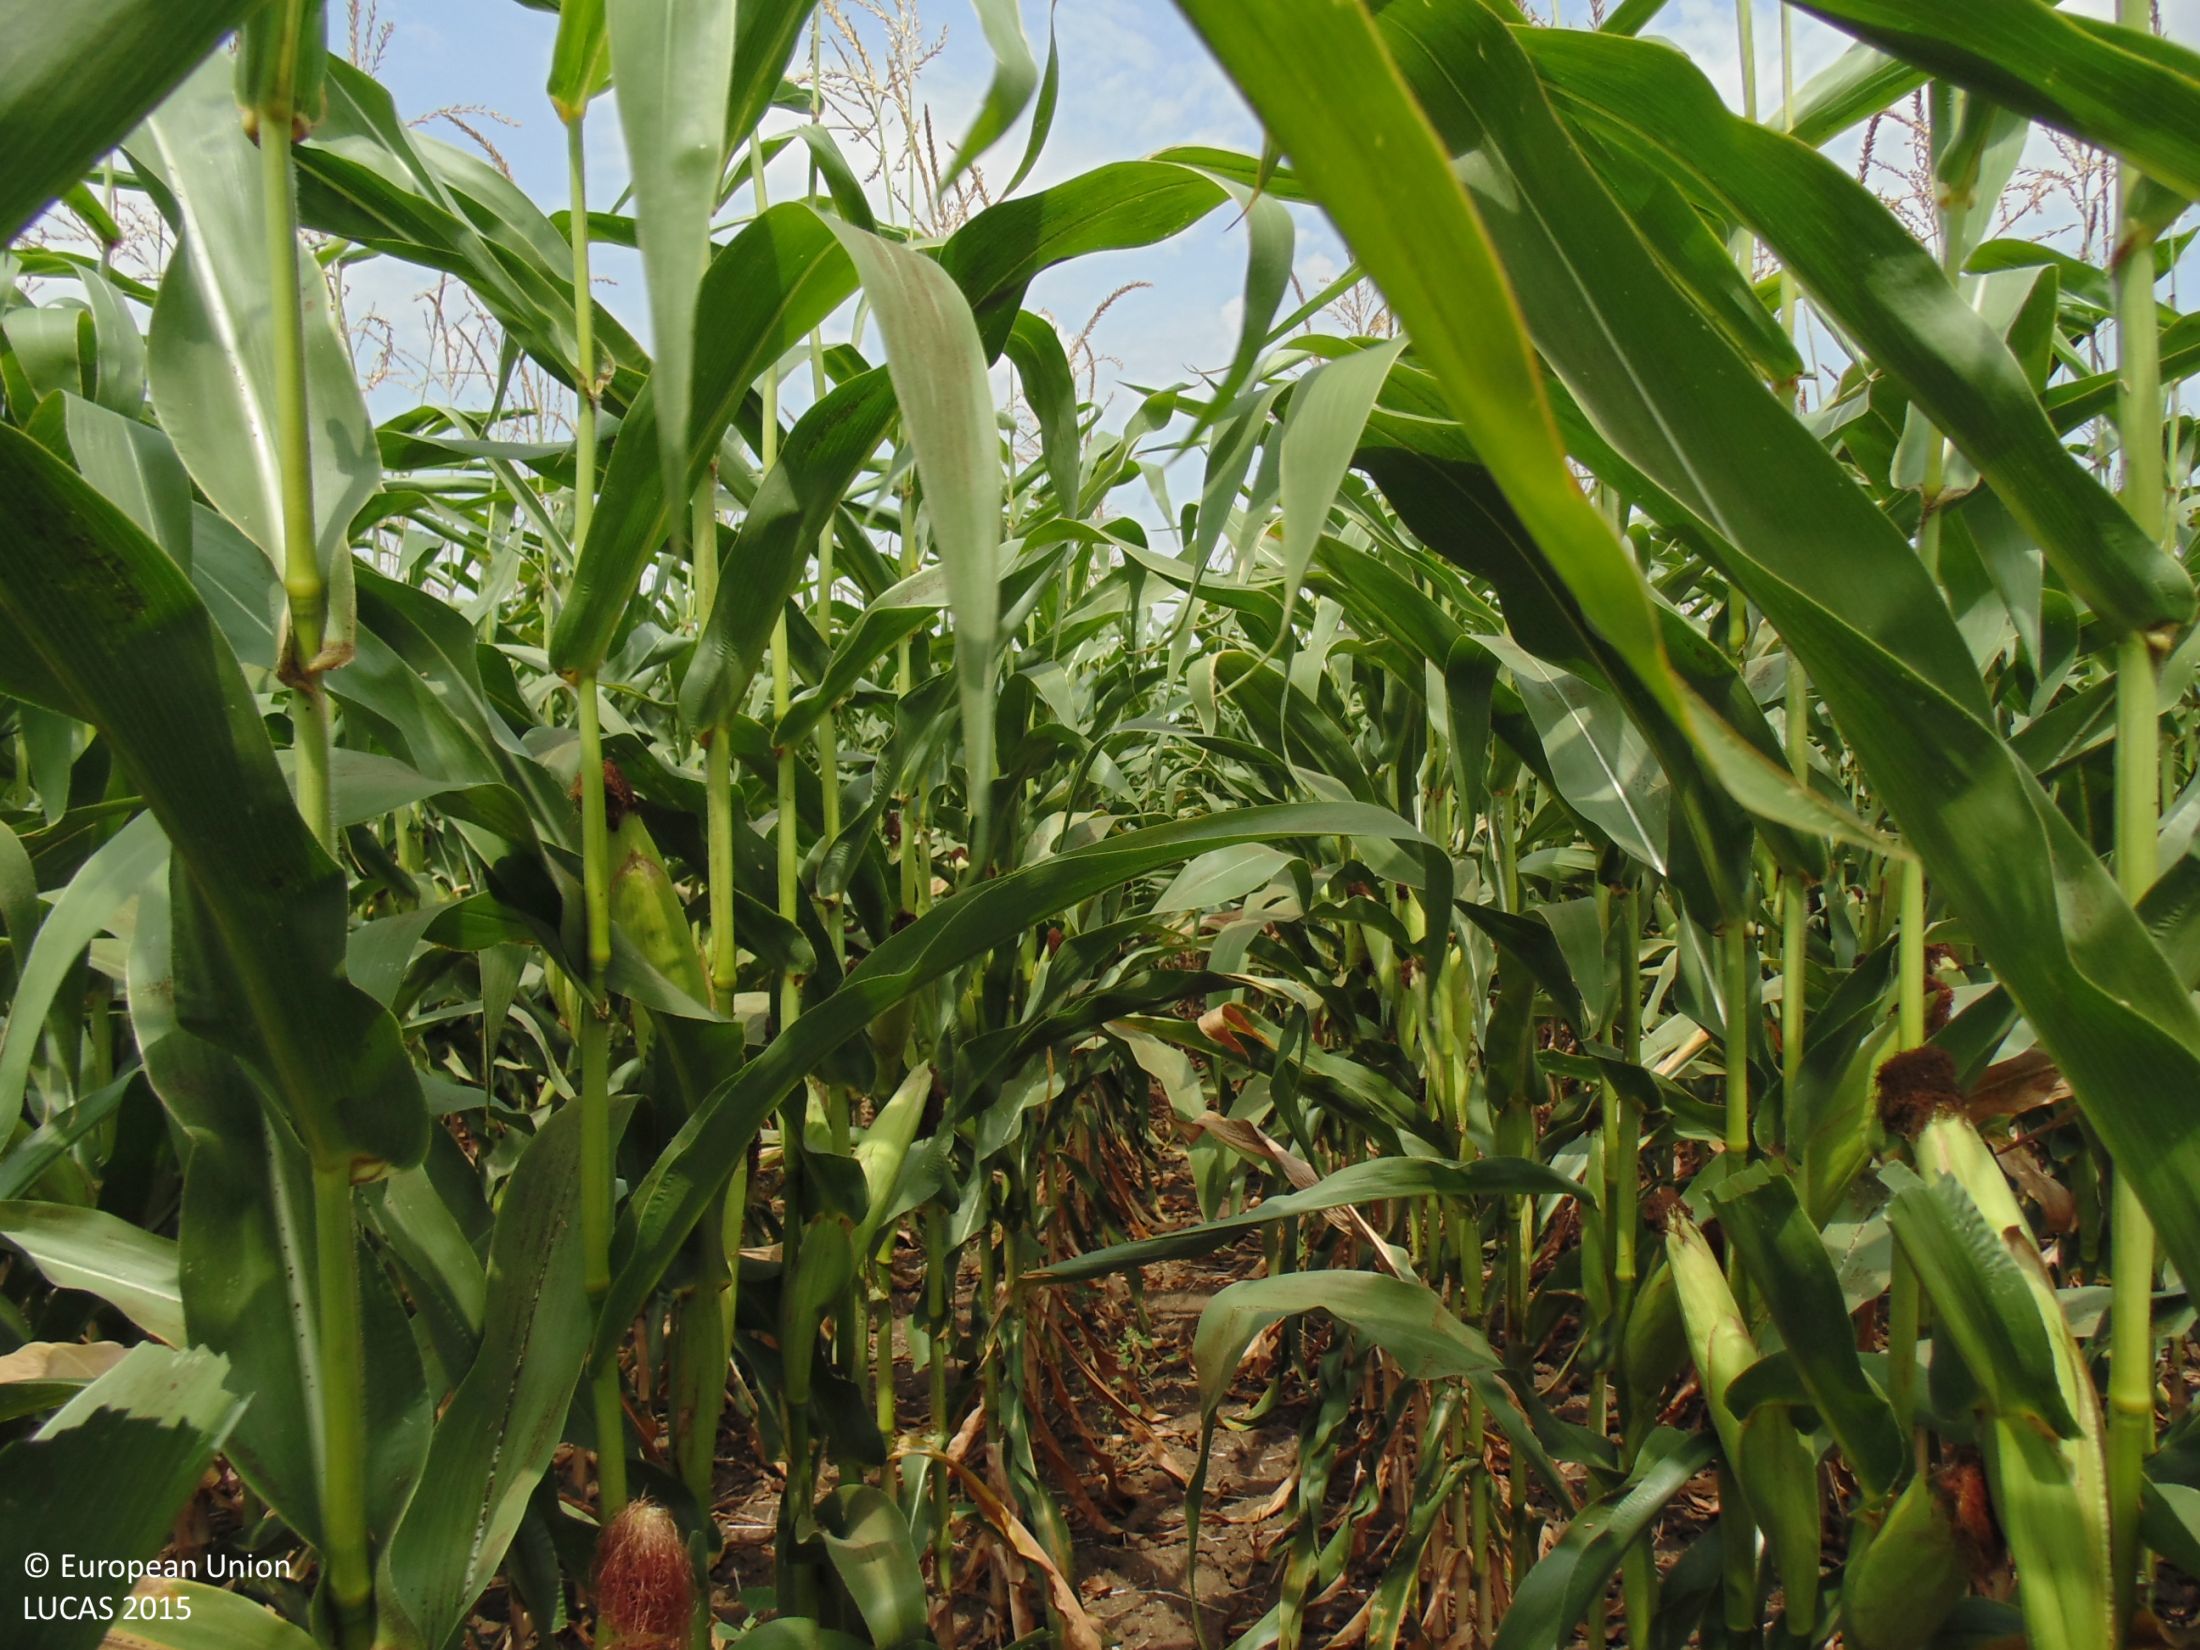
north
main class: Cropland
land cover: Maize
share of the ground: > 75 %
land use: Agriculture (excluding fallow land and kitchen gardens)
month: August
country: BG
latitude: 43.7661
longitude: 28.1534
